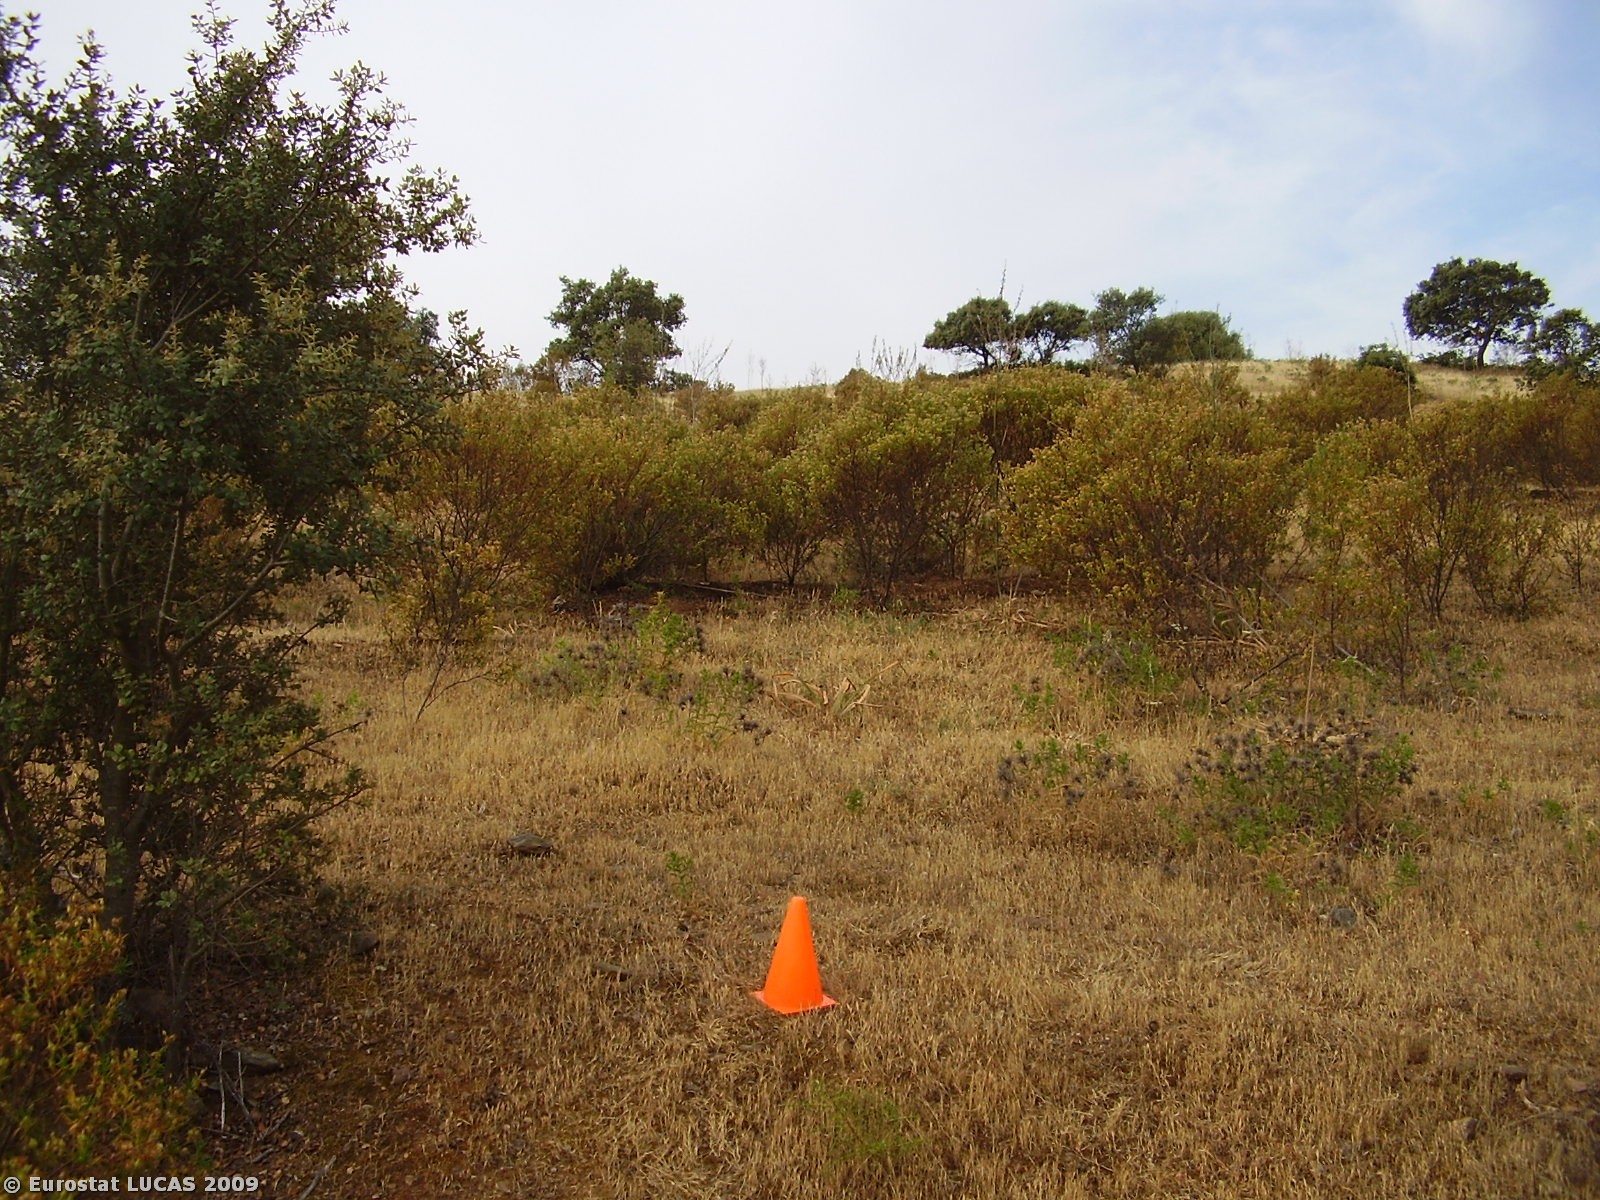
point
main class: Woodland
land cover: Broadleaved woodland
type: broadleaved evergreen forest
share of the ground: 50 - 75 %
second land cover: Spontaneously vegetated surfaces
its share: 50 - 75 %
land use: Forestry
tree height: > 5 m
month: May
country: PT
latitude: 37.5942
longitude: -7.5791
